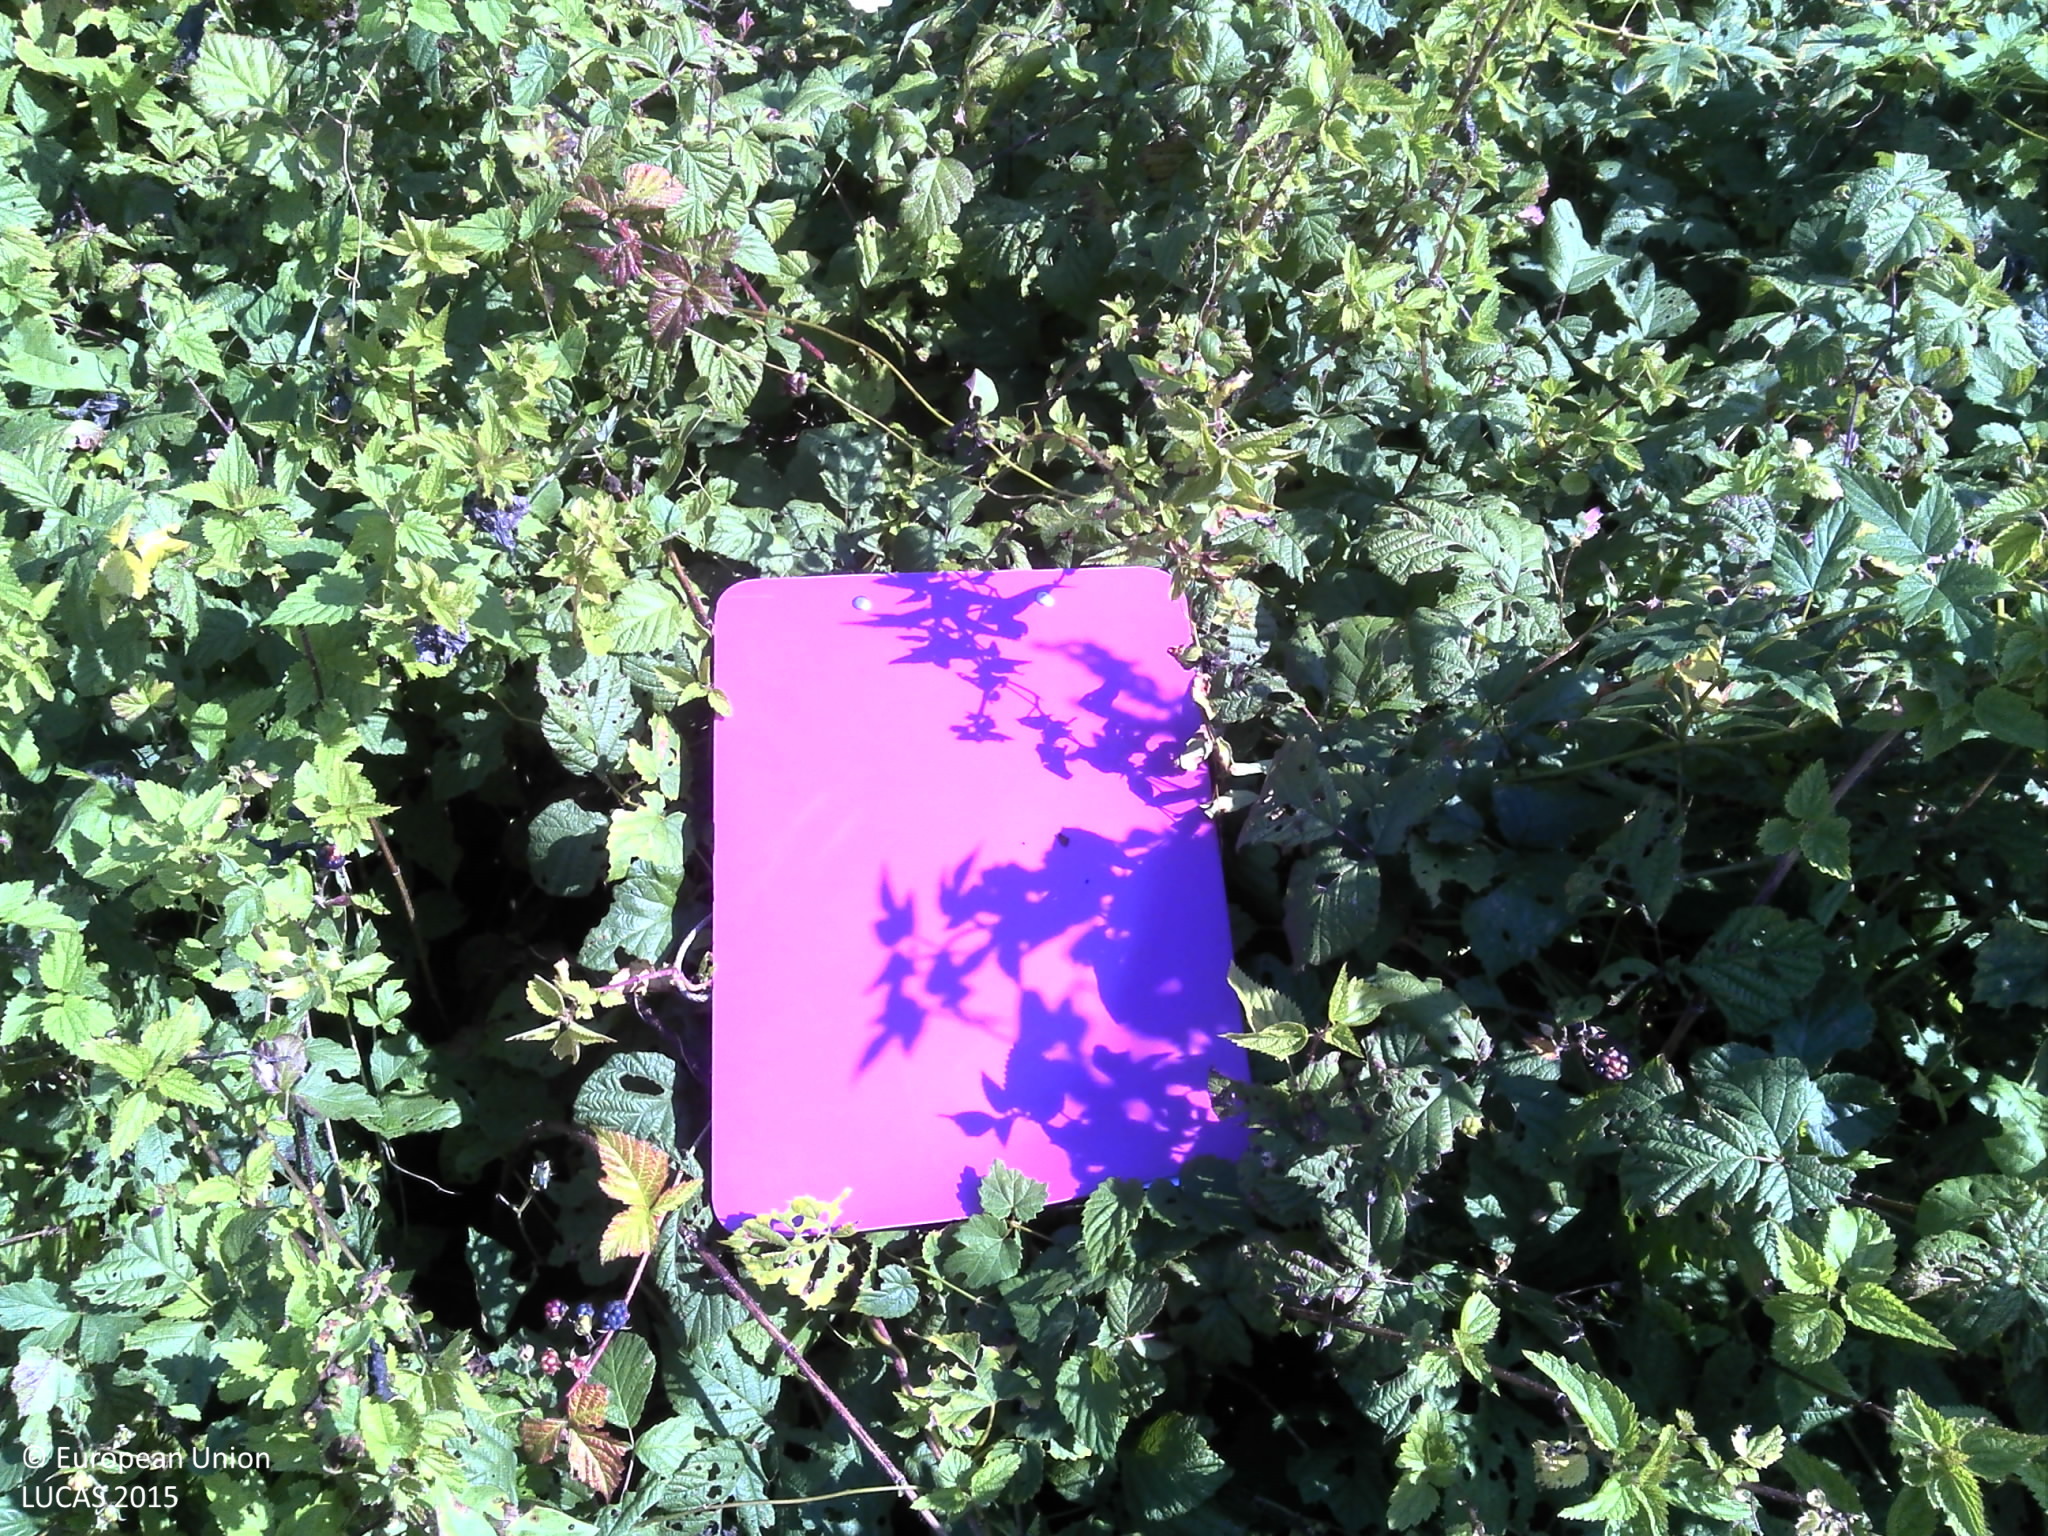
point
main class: Grassland
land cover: Spontaneously vegetated surfaces
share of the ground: > 75 %
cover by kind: herbaceous plants 100 %
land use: Semi-natural and natural areas not in use
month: September
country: HR
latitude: 45.5637
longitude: 16.3913
